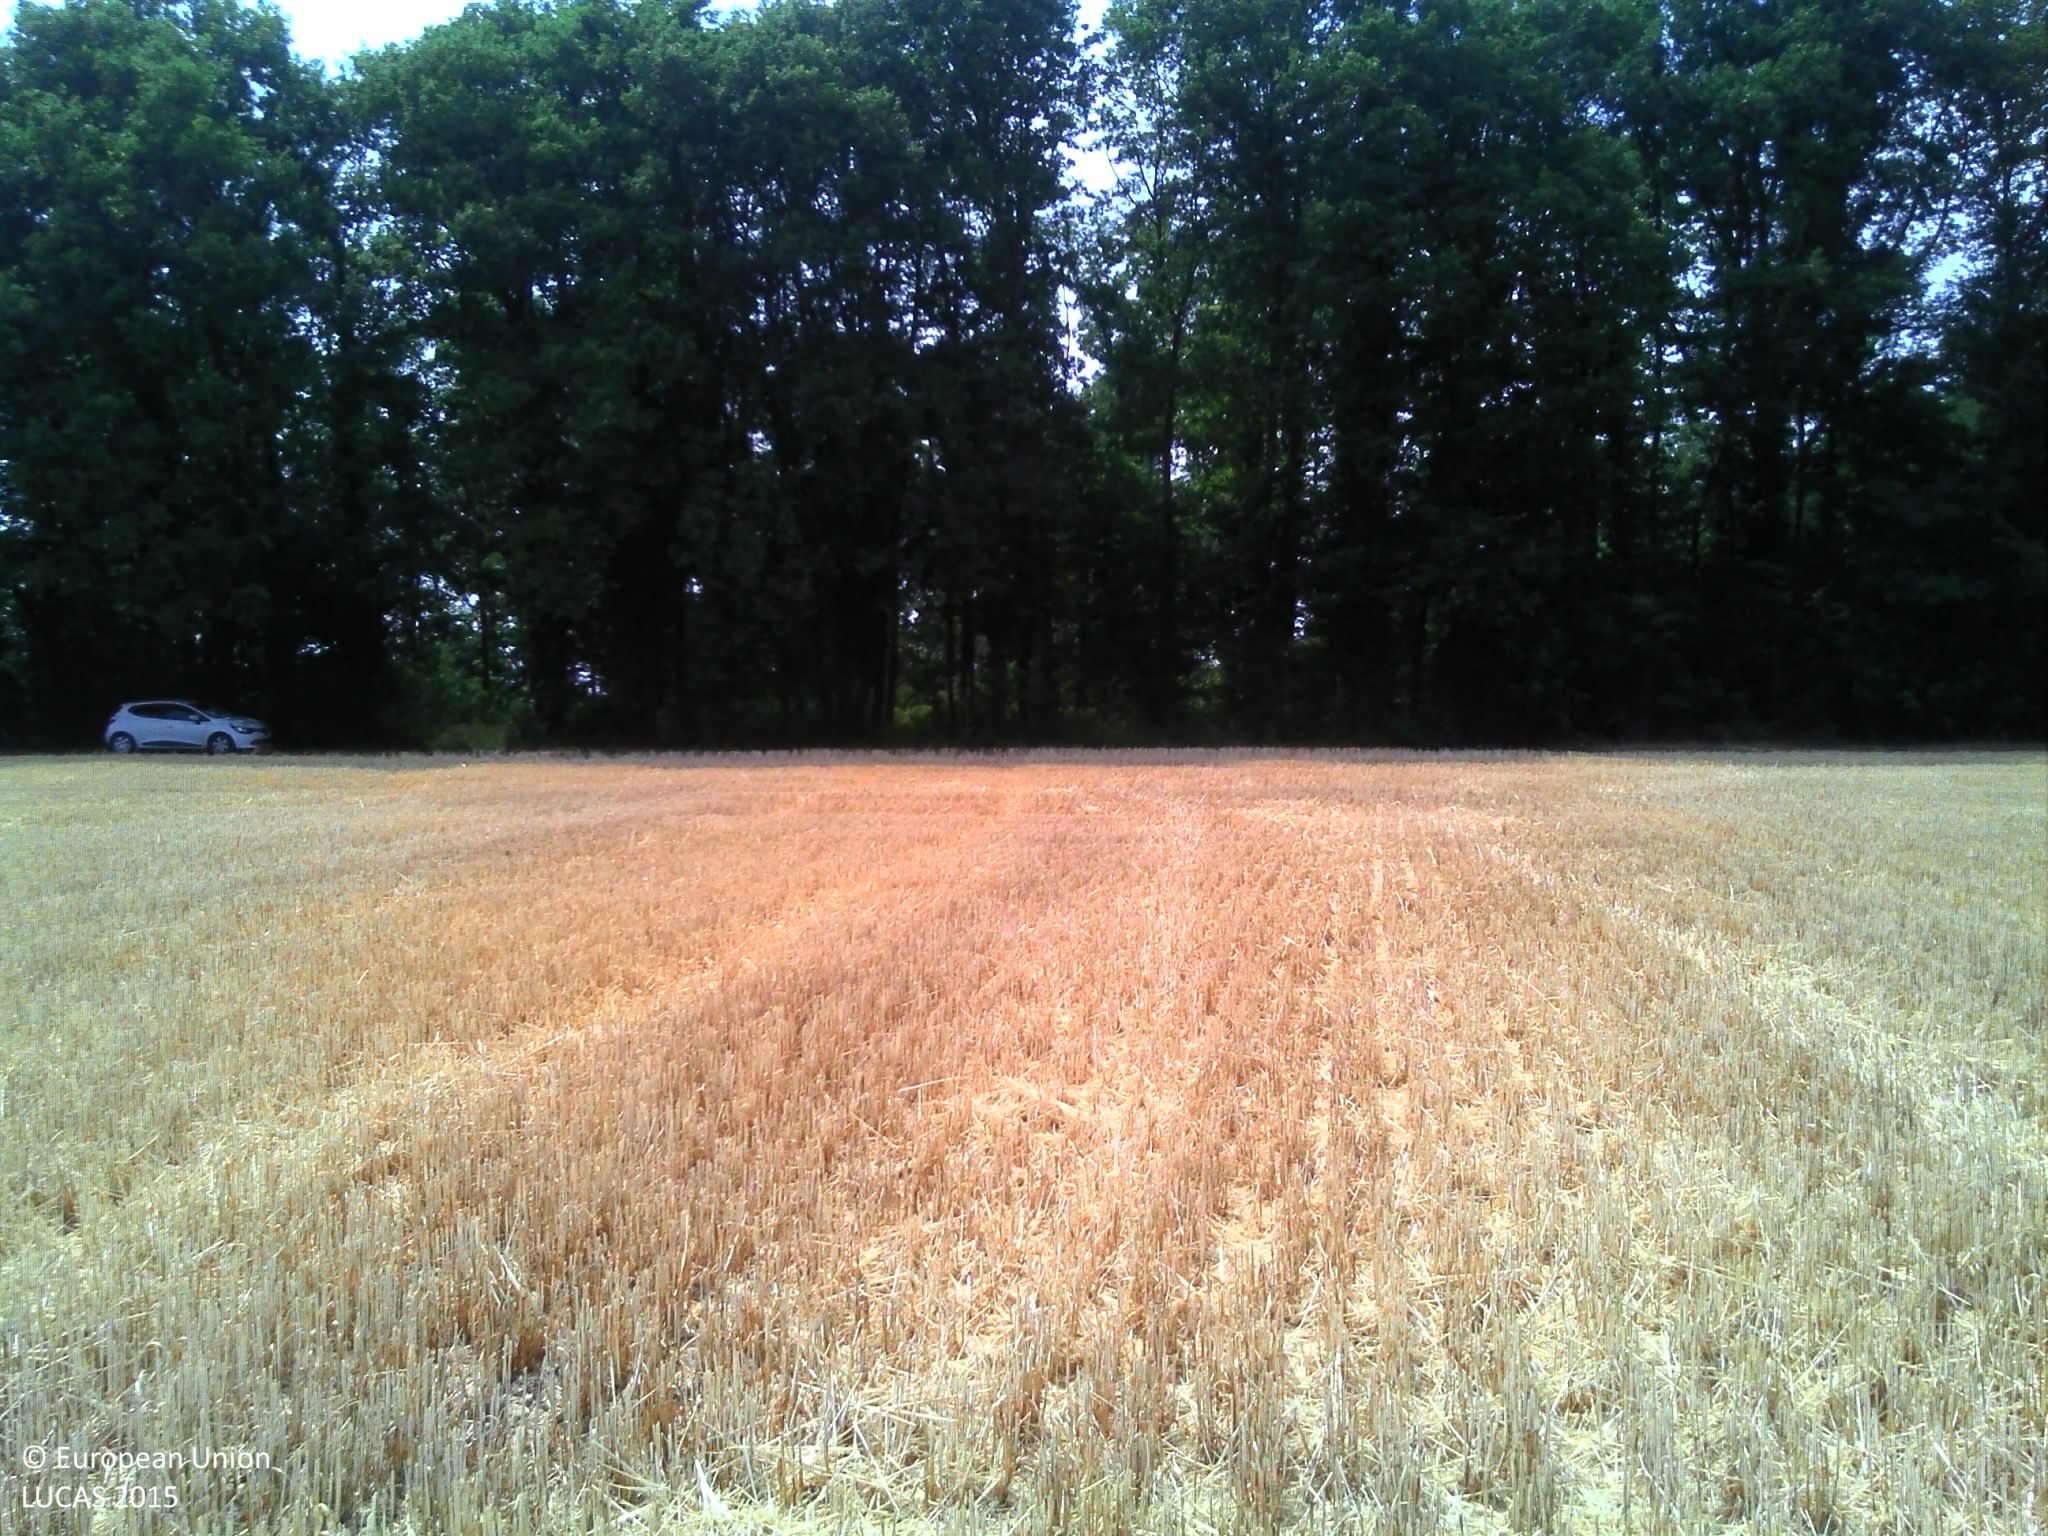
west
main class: Cropland
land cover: Barley
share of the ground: > 75 %
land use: Agriculture (excluding fallow land and kitchen gardens)
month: July
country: FR
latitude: 47.9716
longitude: 2.8257
